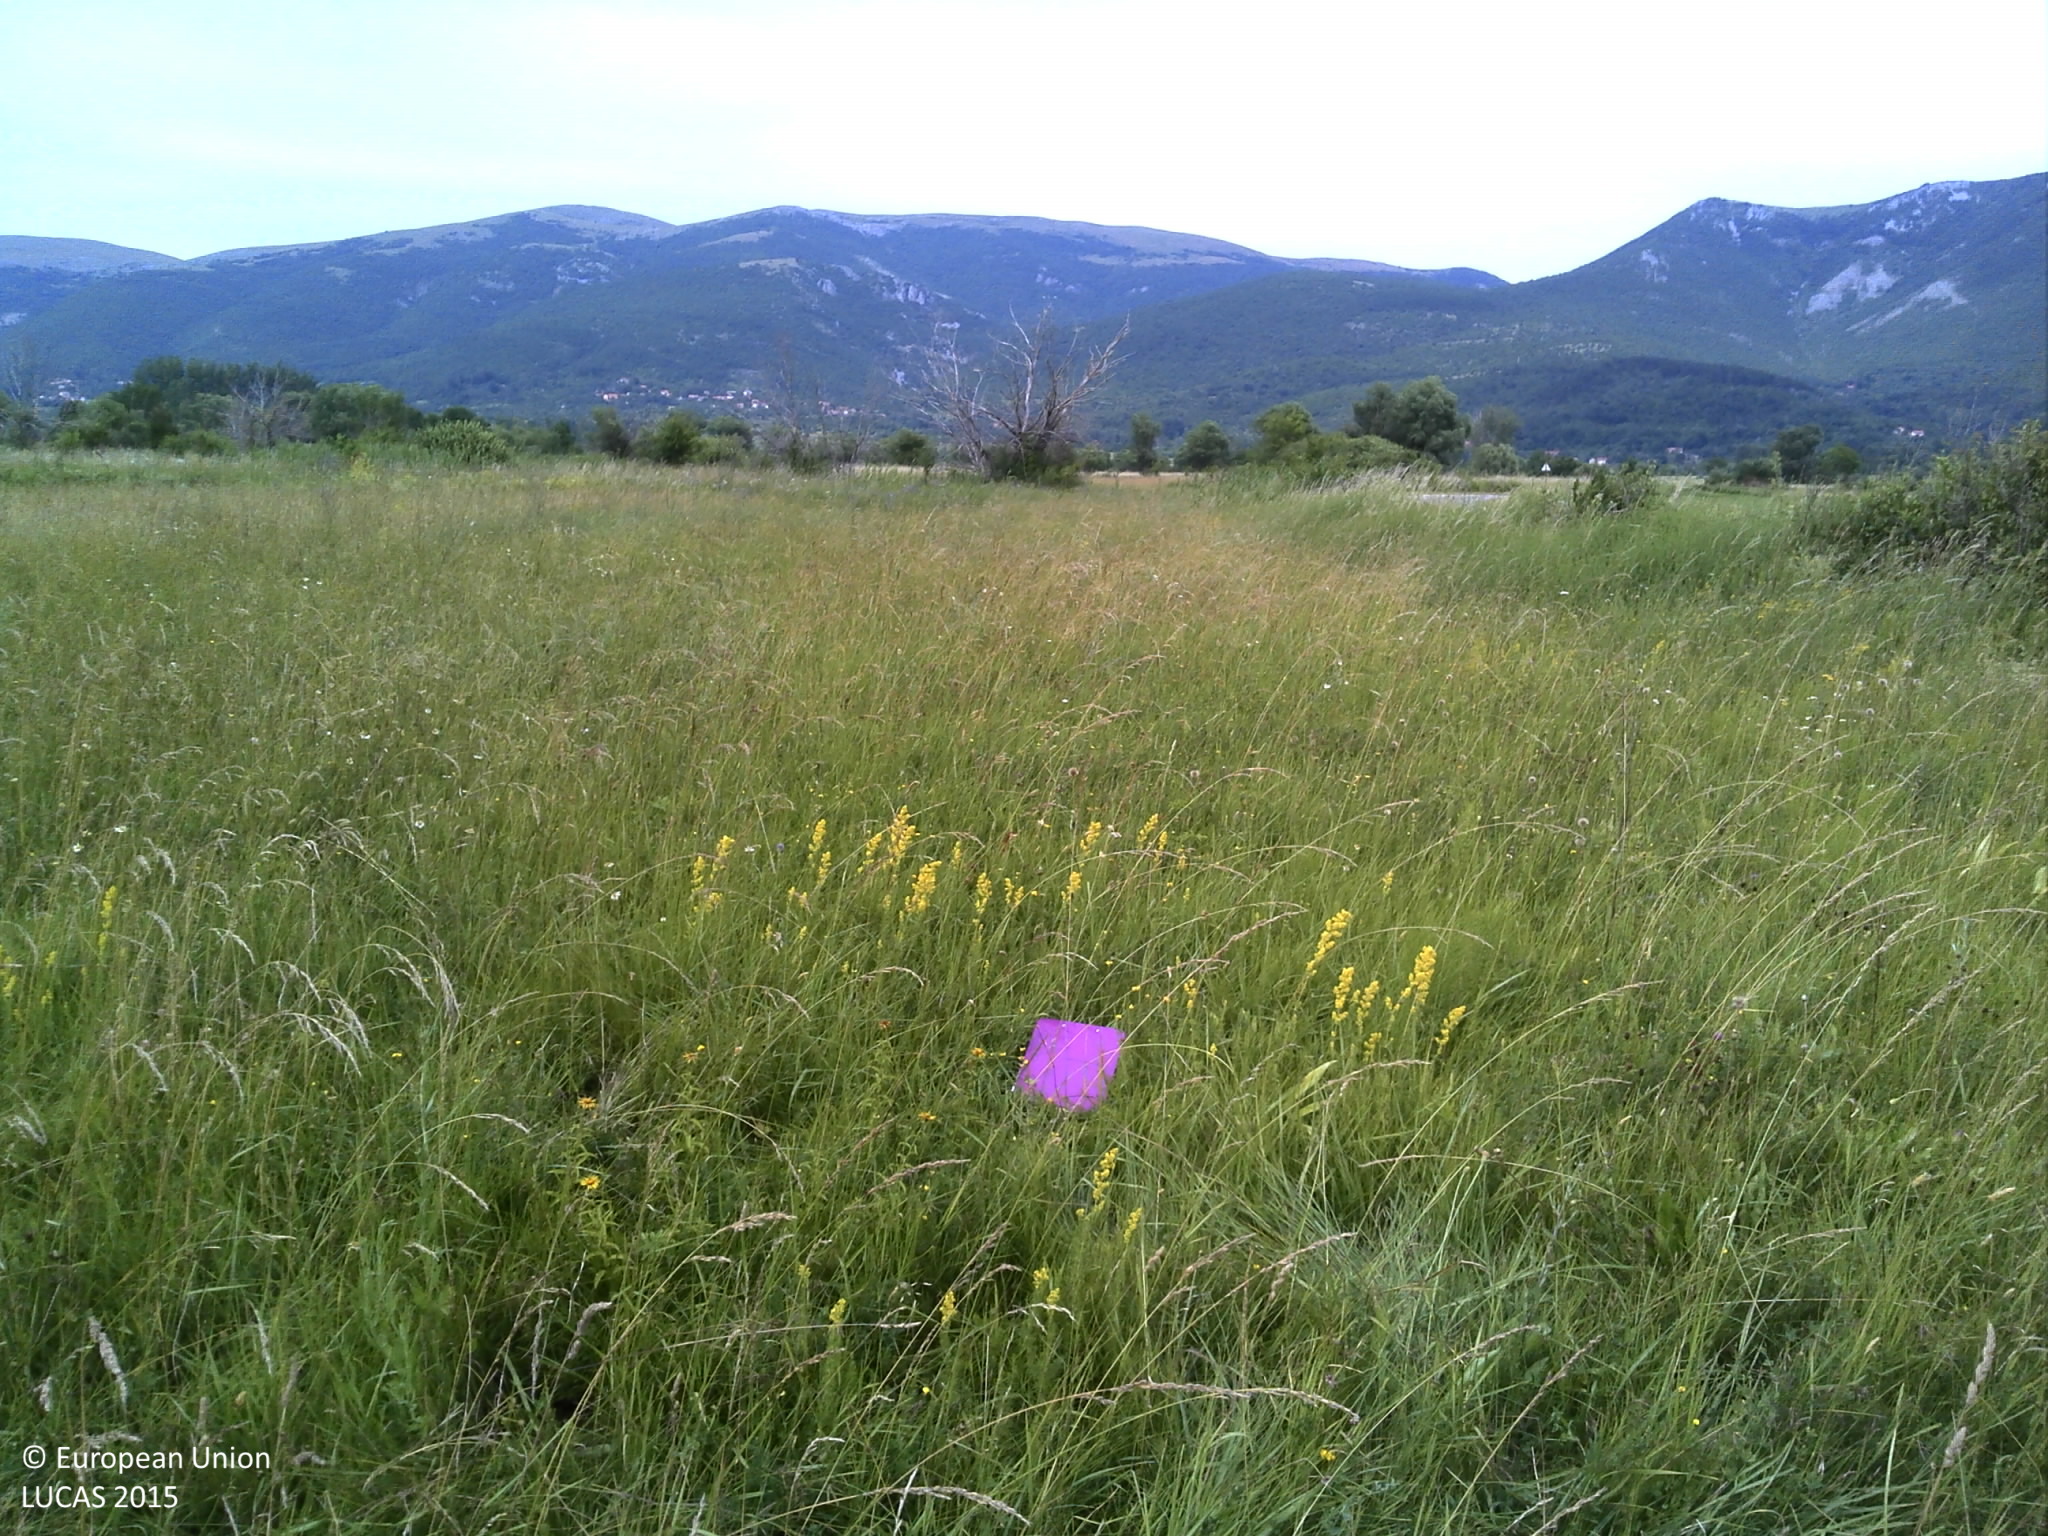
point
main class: Grassland
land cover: Spontaneously vegetated surfaces
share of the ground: > 75 %
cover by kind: herbaceous plants 95 %, shrubs 5 %
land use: Fallow land
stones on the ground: < 10 %
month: June
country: HR
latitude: 44.1496
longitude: 16.1565
